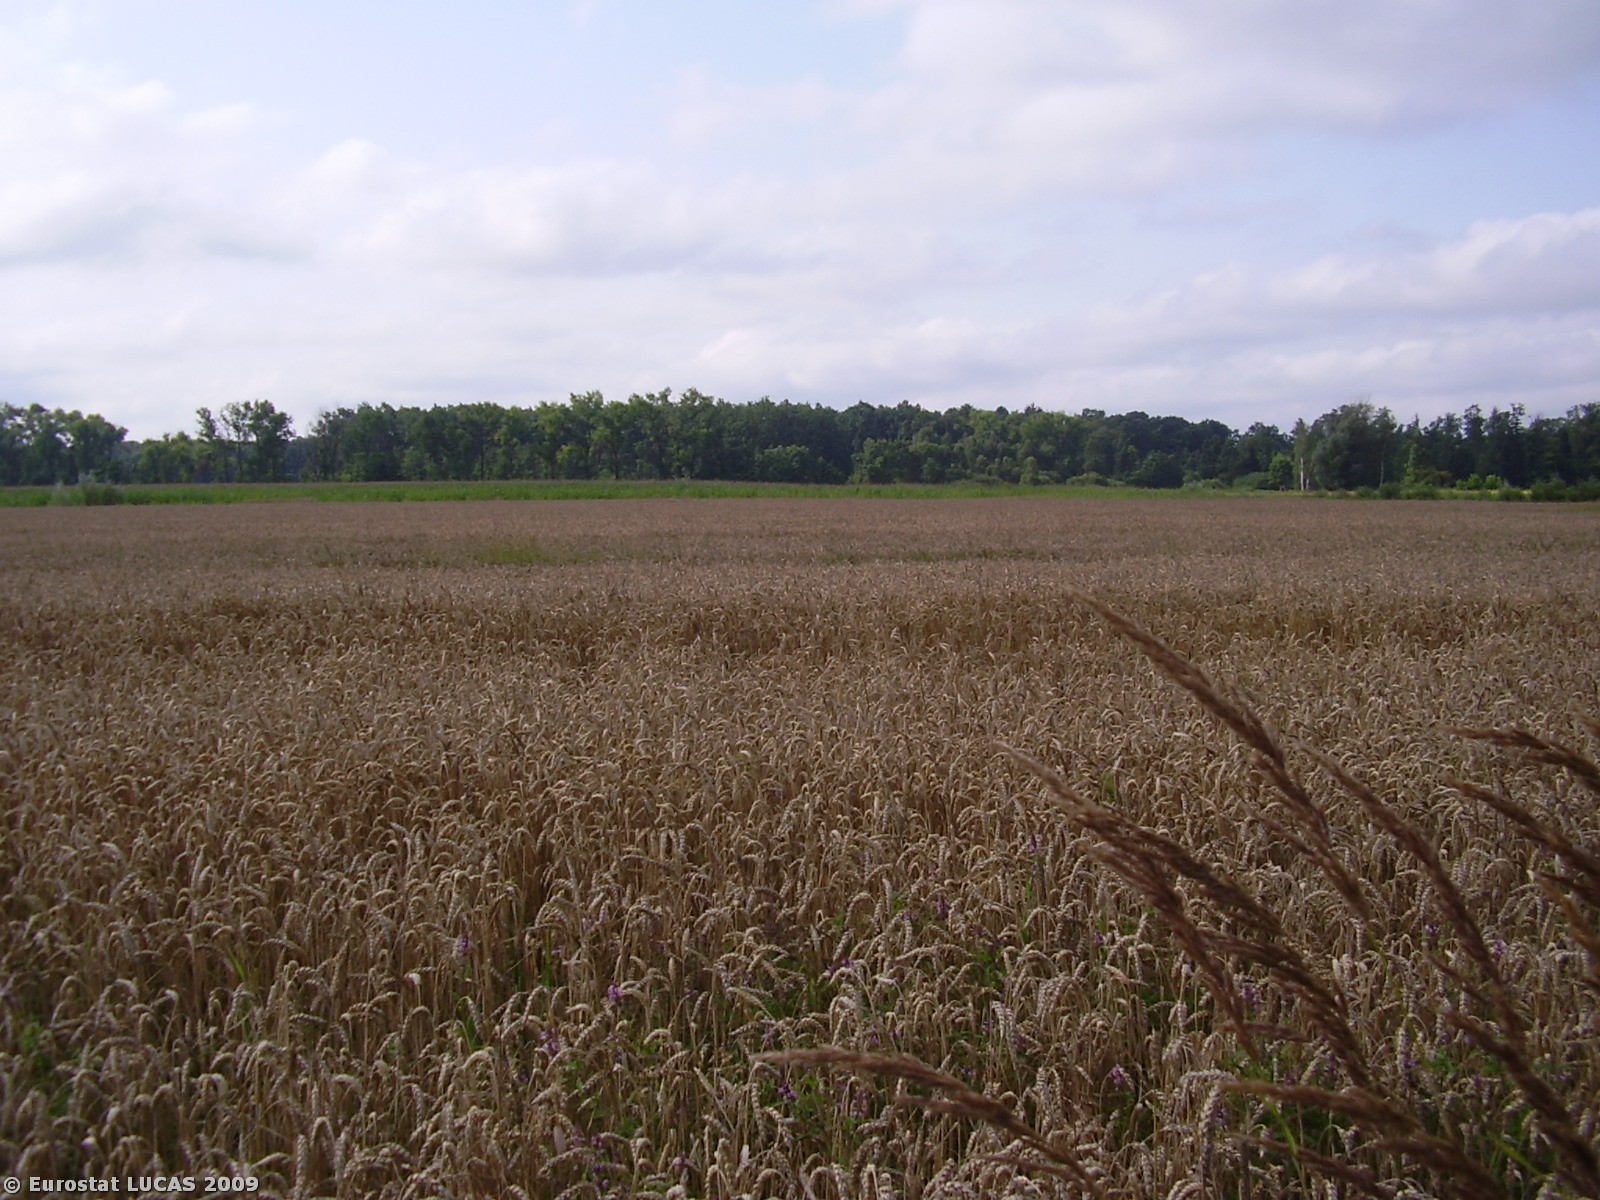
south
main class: Cropland
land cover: Common wheat
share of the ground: > 75 %
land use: Agriculture (excluding fallow land and kitchen gardens)
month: May
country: PL
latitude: 51.5118
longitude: 16.8538
